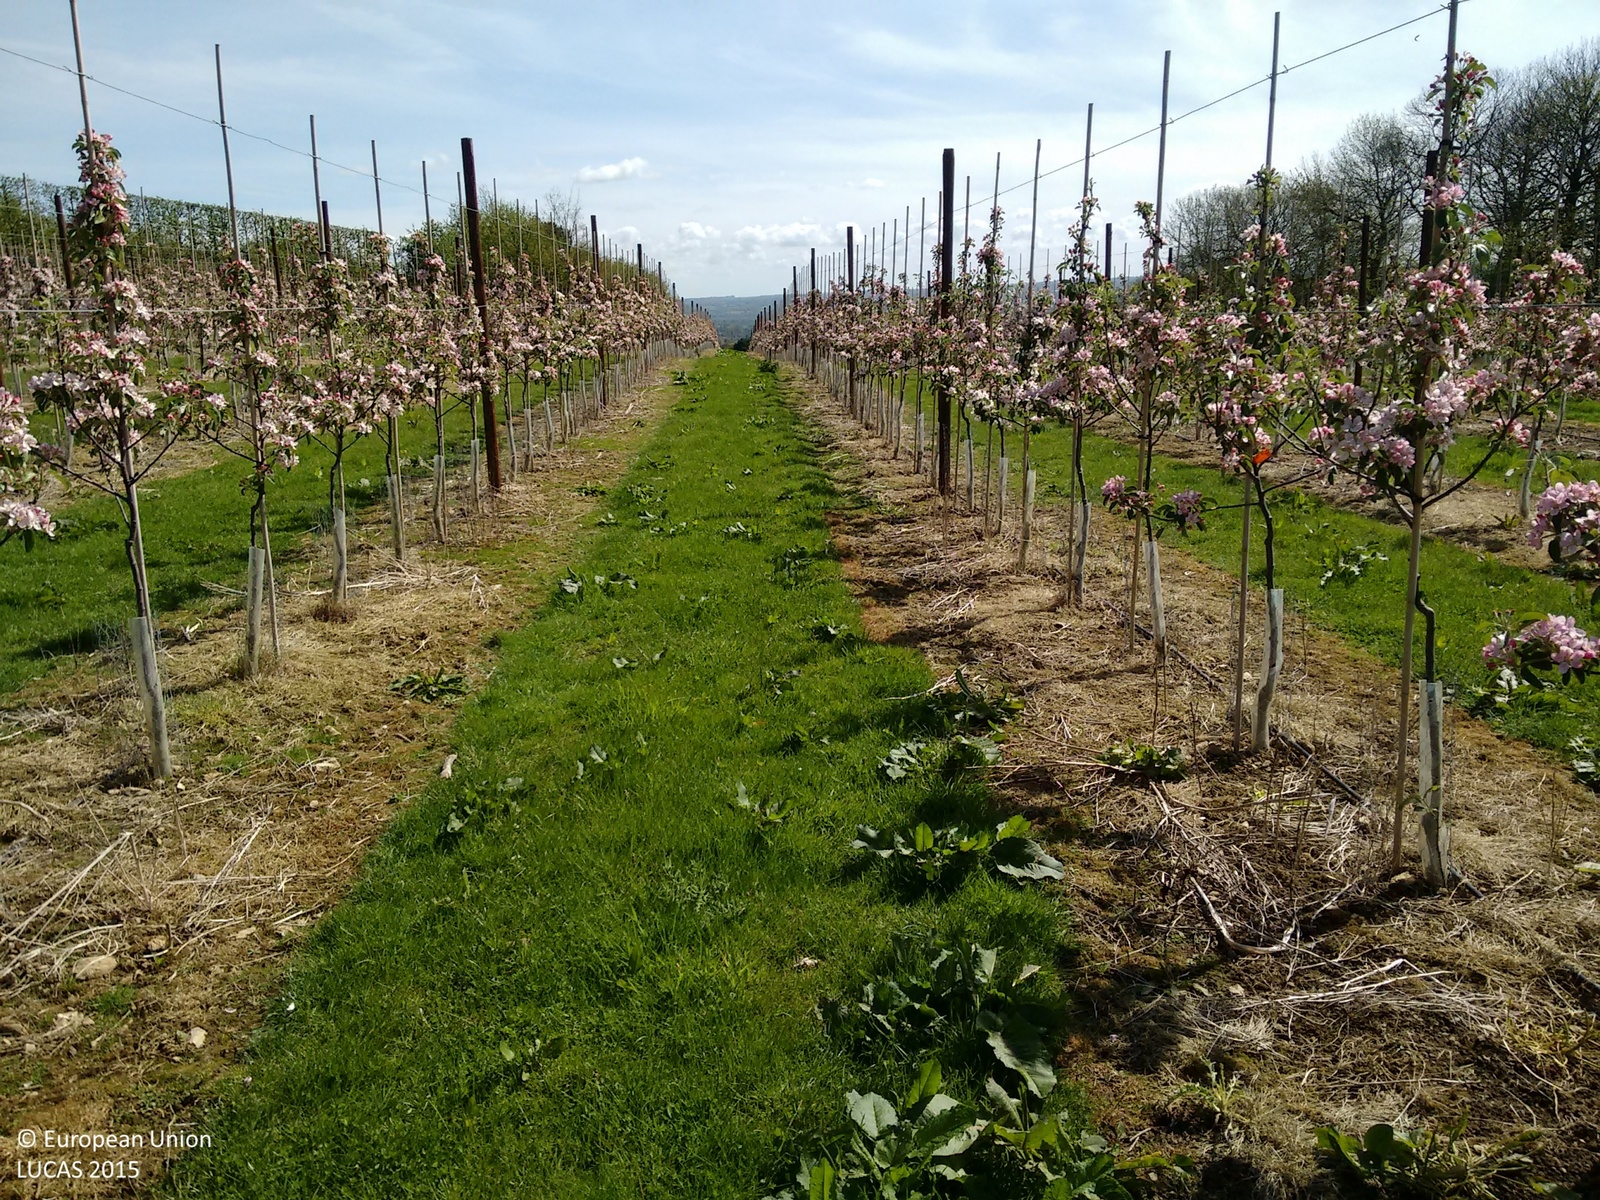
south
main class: Cropland
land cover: Apple fruit
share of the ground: 25 - 50 %
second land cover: Grassland without tree/shrub cover
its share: 50 - 75 %
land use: Agriculture (excluding fallow land and kitchen gardens)
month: May
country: GB
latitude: 51.2572
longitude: 0.3269
